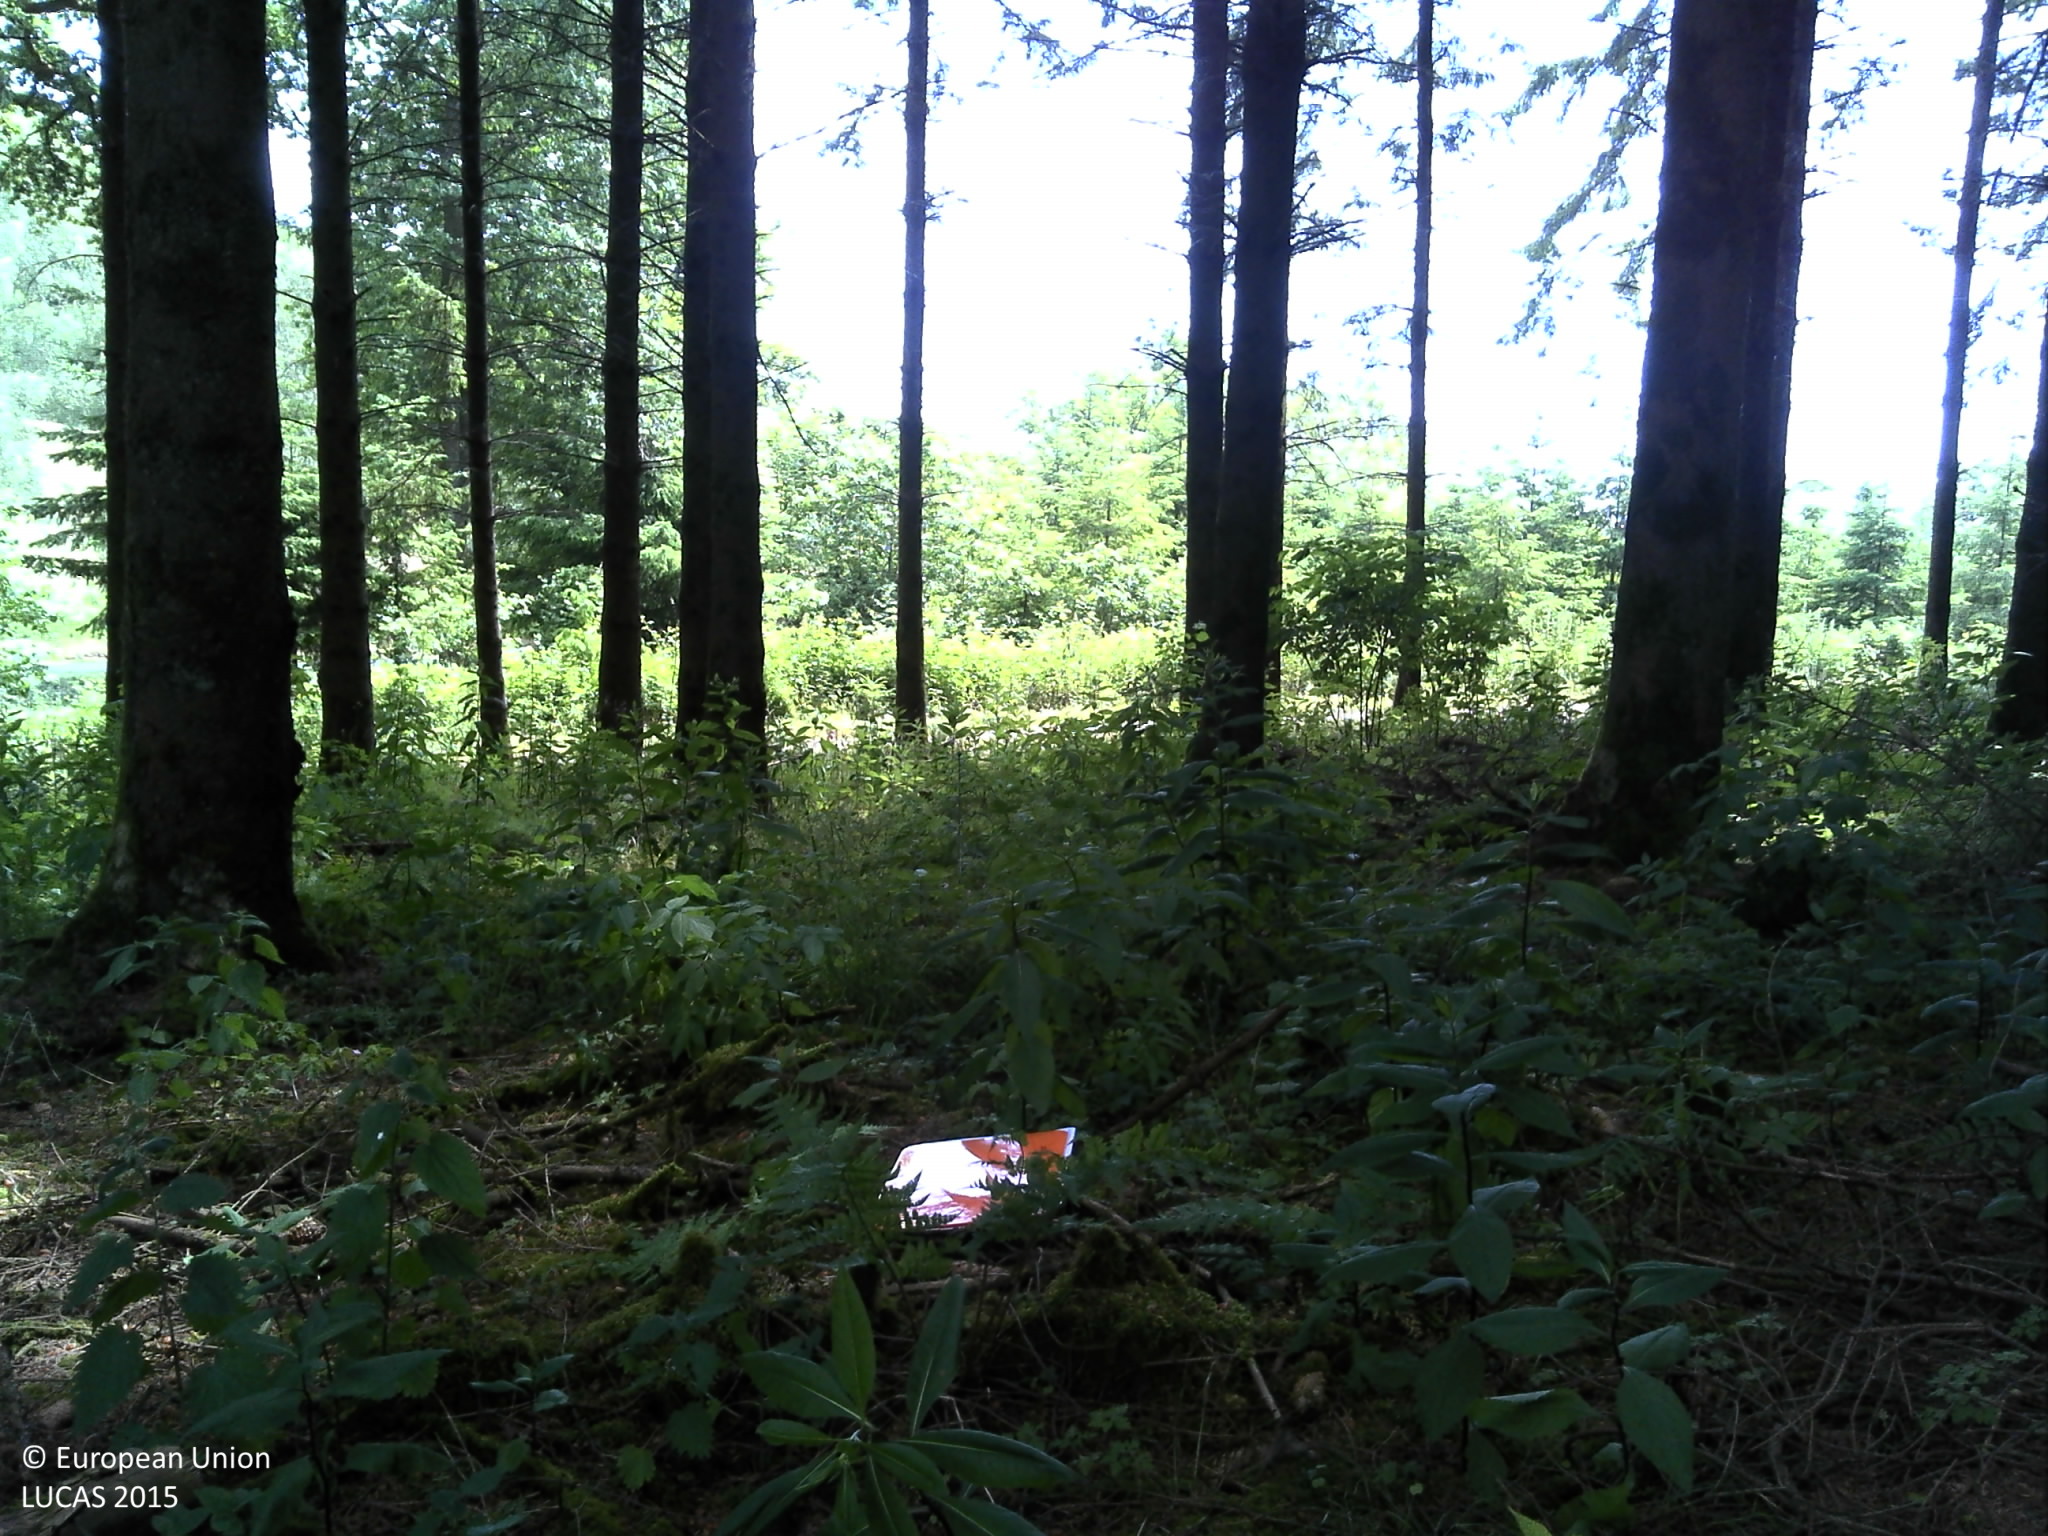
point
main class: Woodland
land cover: Spruce dominated coniferous woodland
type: exotic forest
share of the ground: > 75 %
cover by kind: coniferous forest trees 75 %, herbaceous plants 10 %, lichens and mosses 10 %, consolidated bare surface 5 %
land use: Forestry
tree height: > 5 m
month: June
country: LU
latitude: 50.0039
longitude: 5.9389
